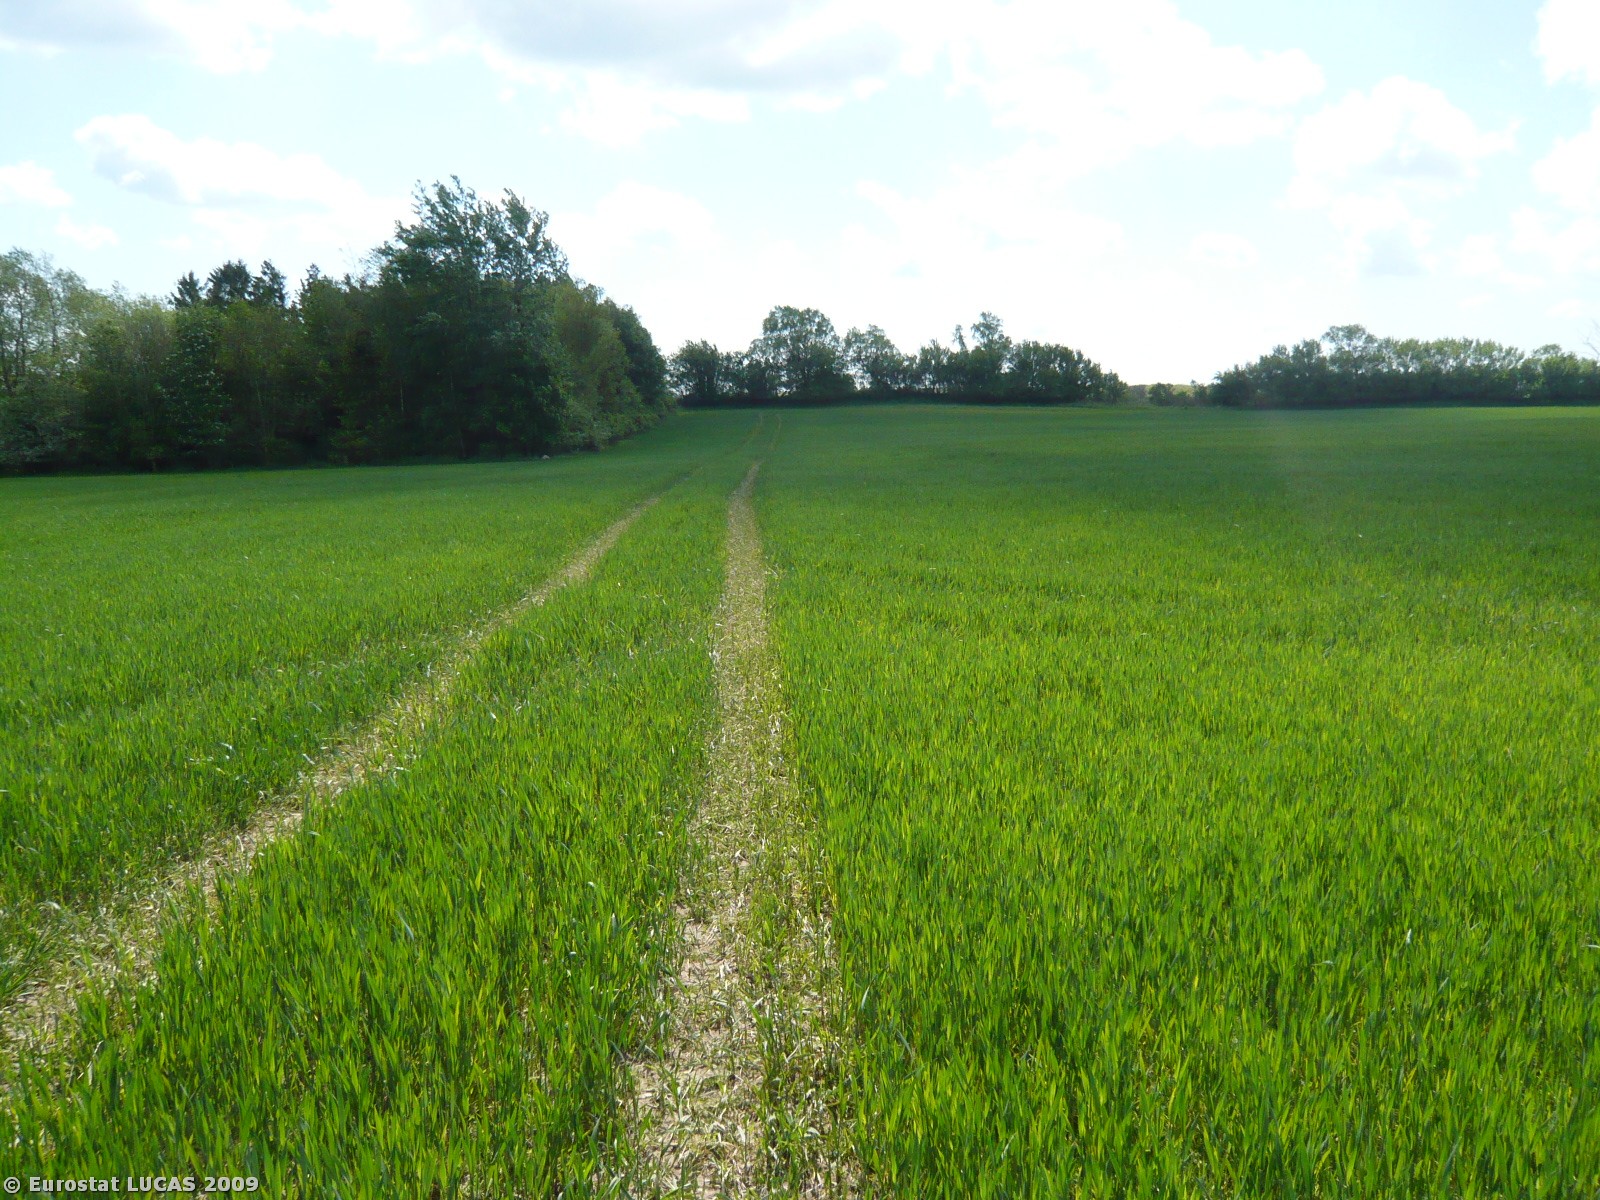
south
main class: Cropland
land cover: Common wheat
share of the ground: > 75 %
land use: Agriculture (excluding fallow land and kitchen gardens)
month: May
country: DK
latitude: 55.3979
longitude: 12.0669
